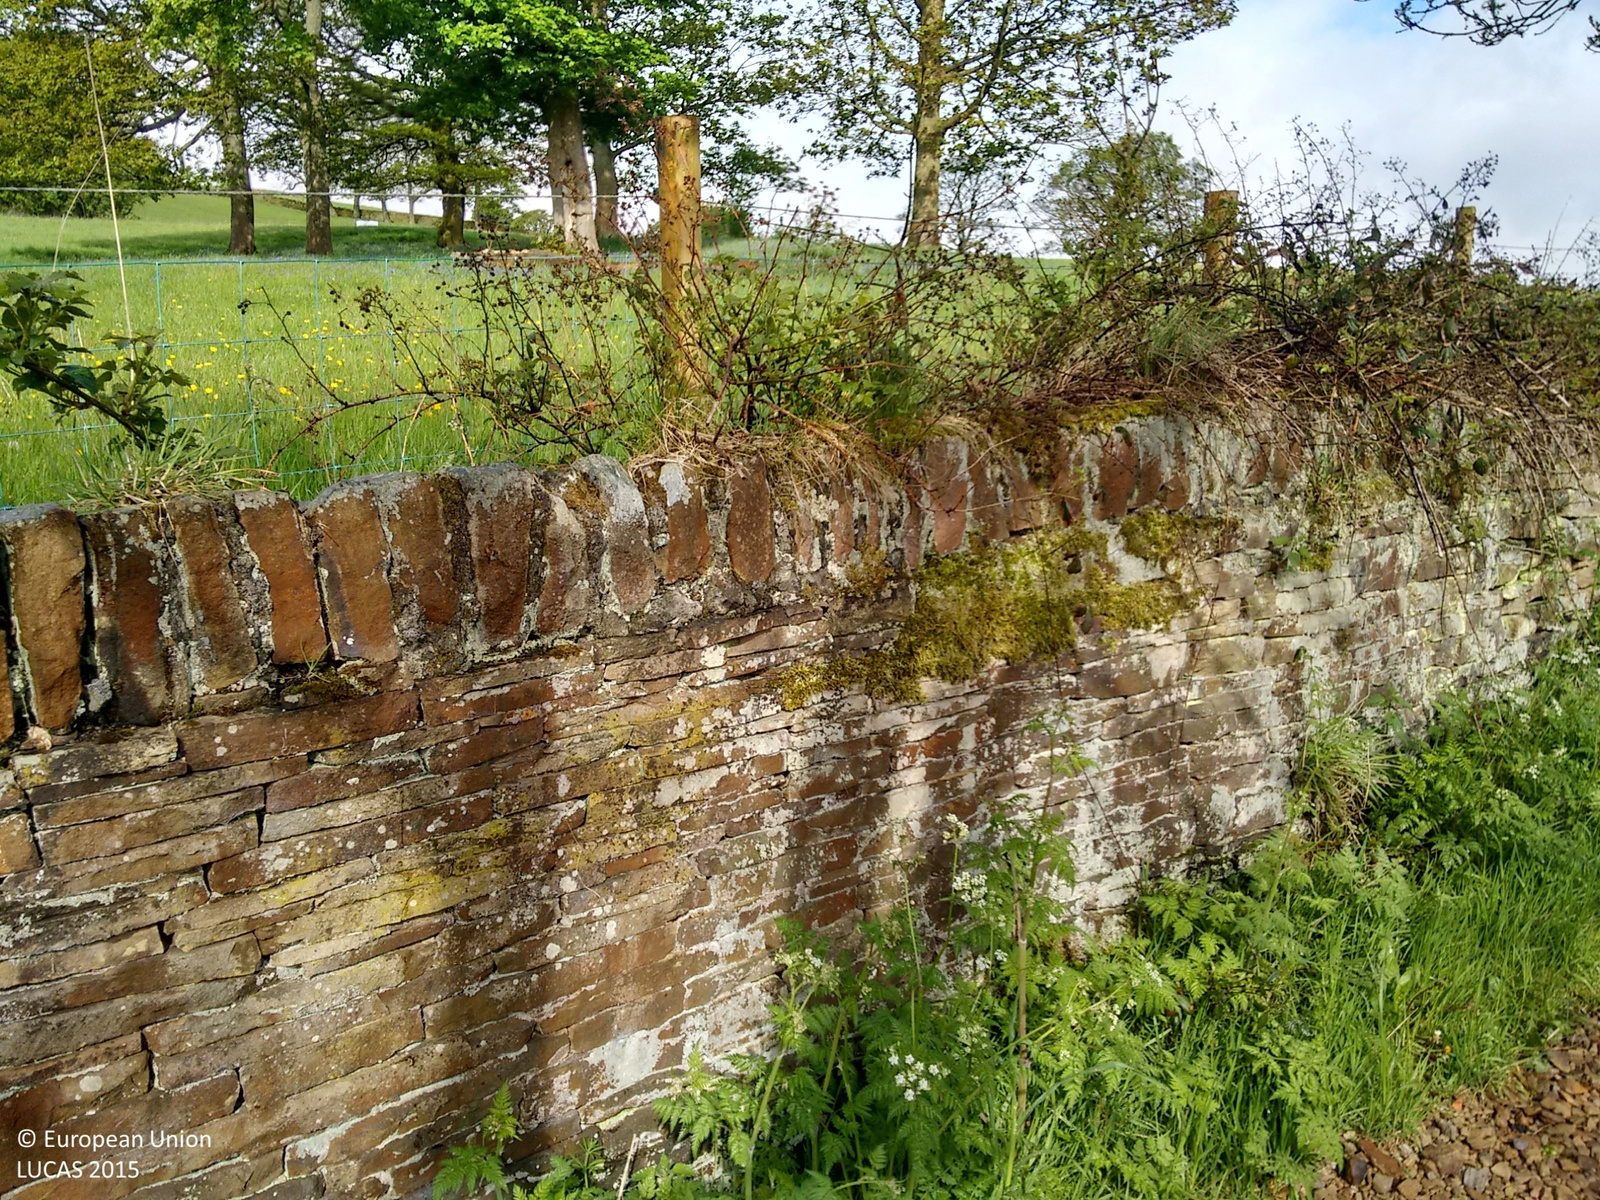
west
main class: Grassland
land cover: Grassland without tree/shrub cover
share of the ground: > 75 %
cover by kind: herbaceous plants 100 %
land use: Agriculture (excluding fallow land and kitchen gardens)
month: May
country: GB
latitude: 53.6696
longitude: -1.8765
